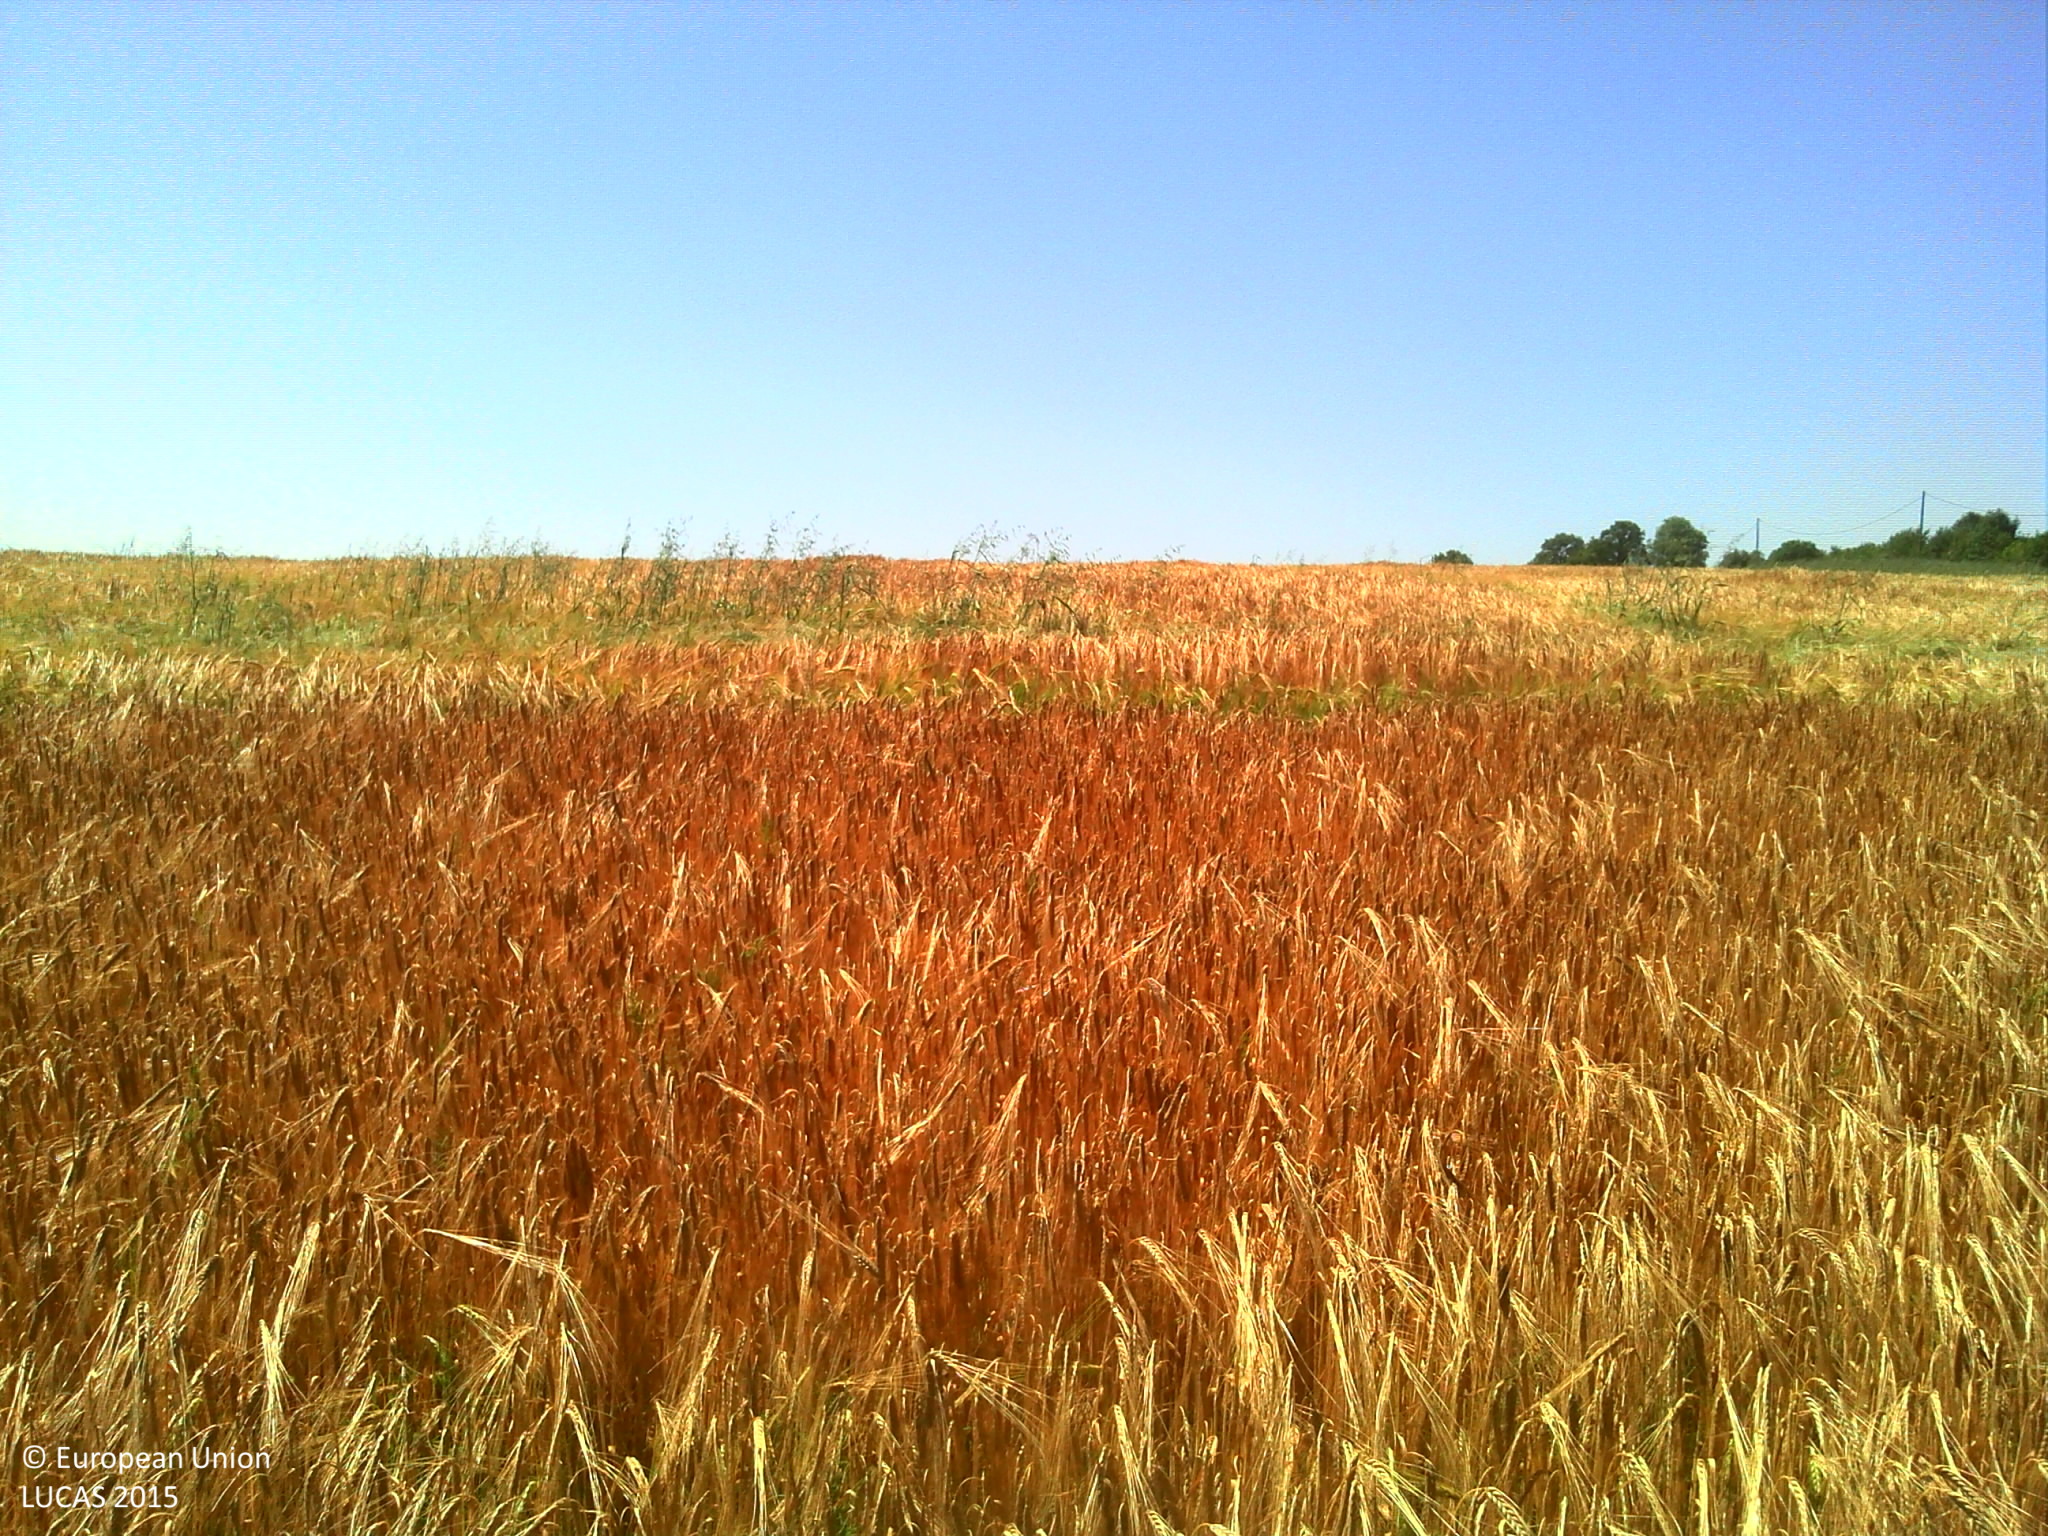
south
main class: Cropland
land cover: Barley
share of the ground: > 75 %
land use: Agriculture (excluding fallow land and kitchen gardens)
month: June
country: FR
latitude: 48.9952
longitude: 0.1438
